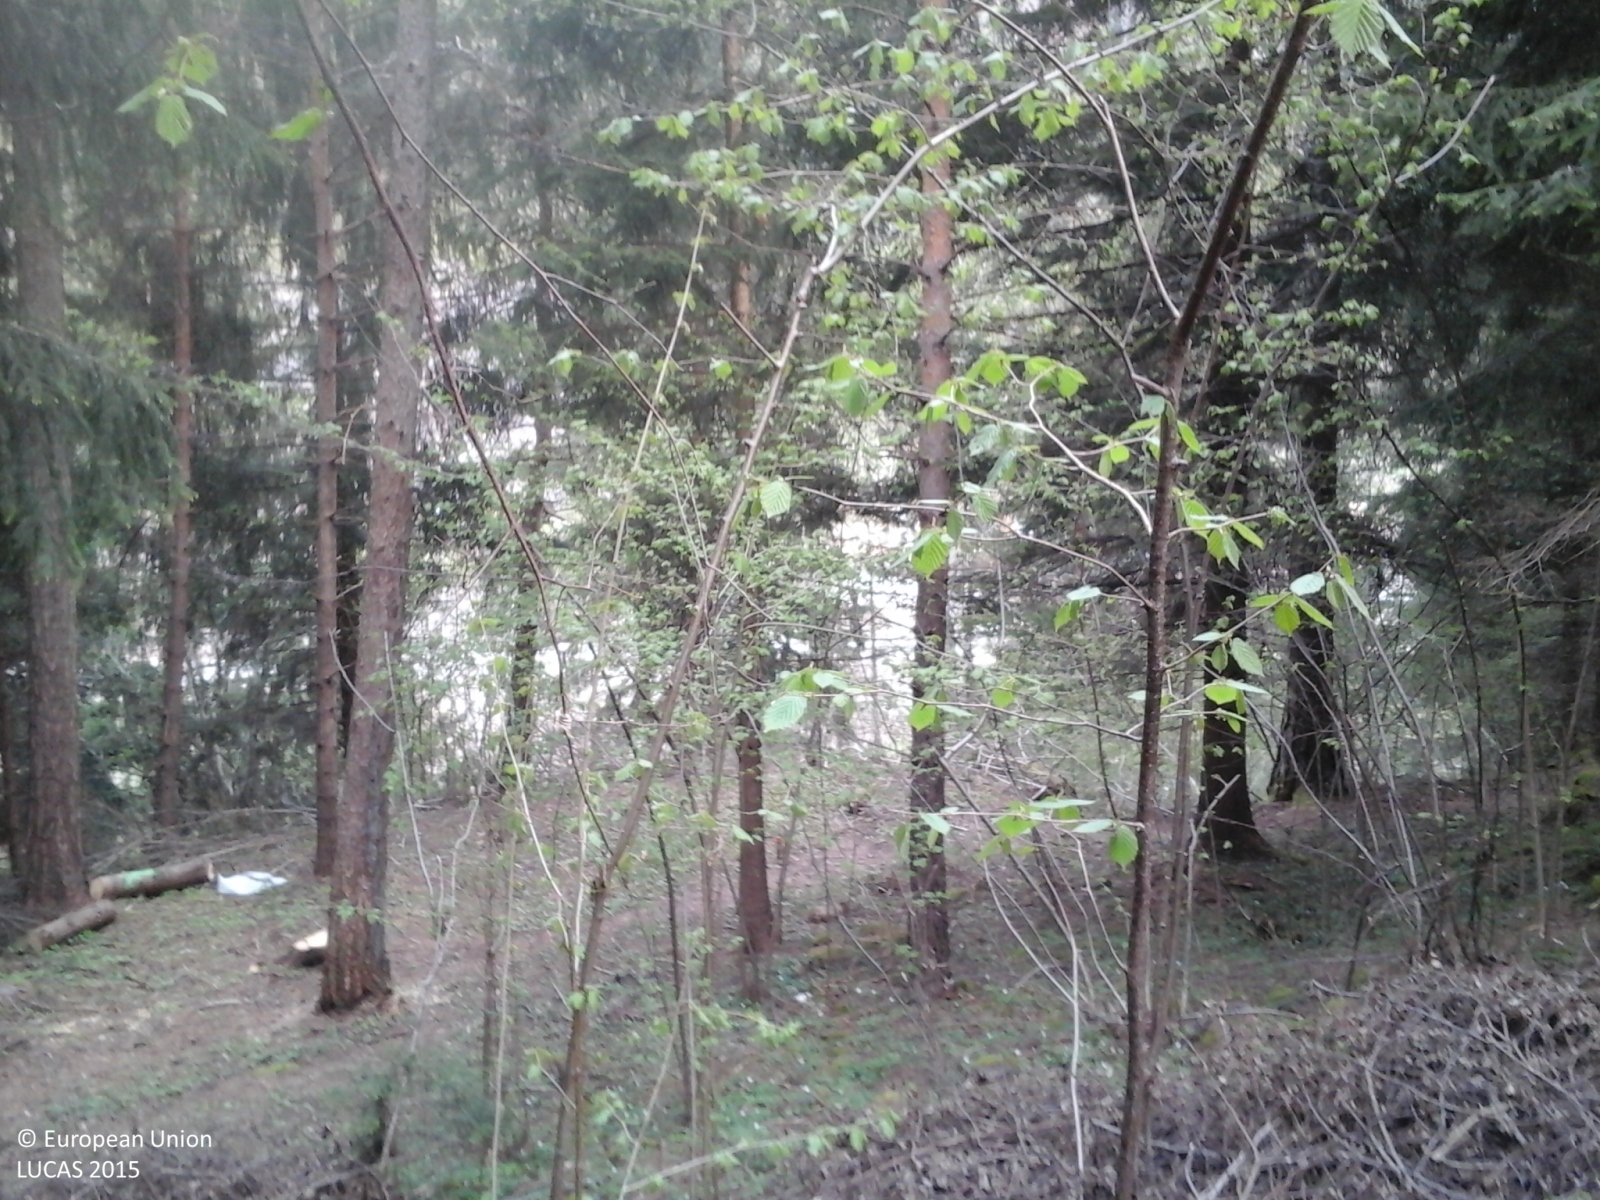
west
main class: Woodland
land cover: Other coniferous woodland
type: alpine coniferous forest
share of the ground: 50 - 75 %
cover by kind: coniferous forest trees 70 %, shrubs 20 %, herbaceous plants 5 %, unconsolidated bare surface 5 %
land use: Forestry
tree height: > 5 m
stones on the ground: < 10 %
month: May
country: IT
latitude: 46.2698
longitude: 11.4125
